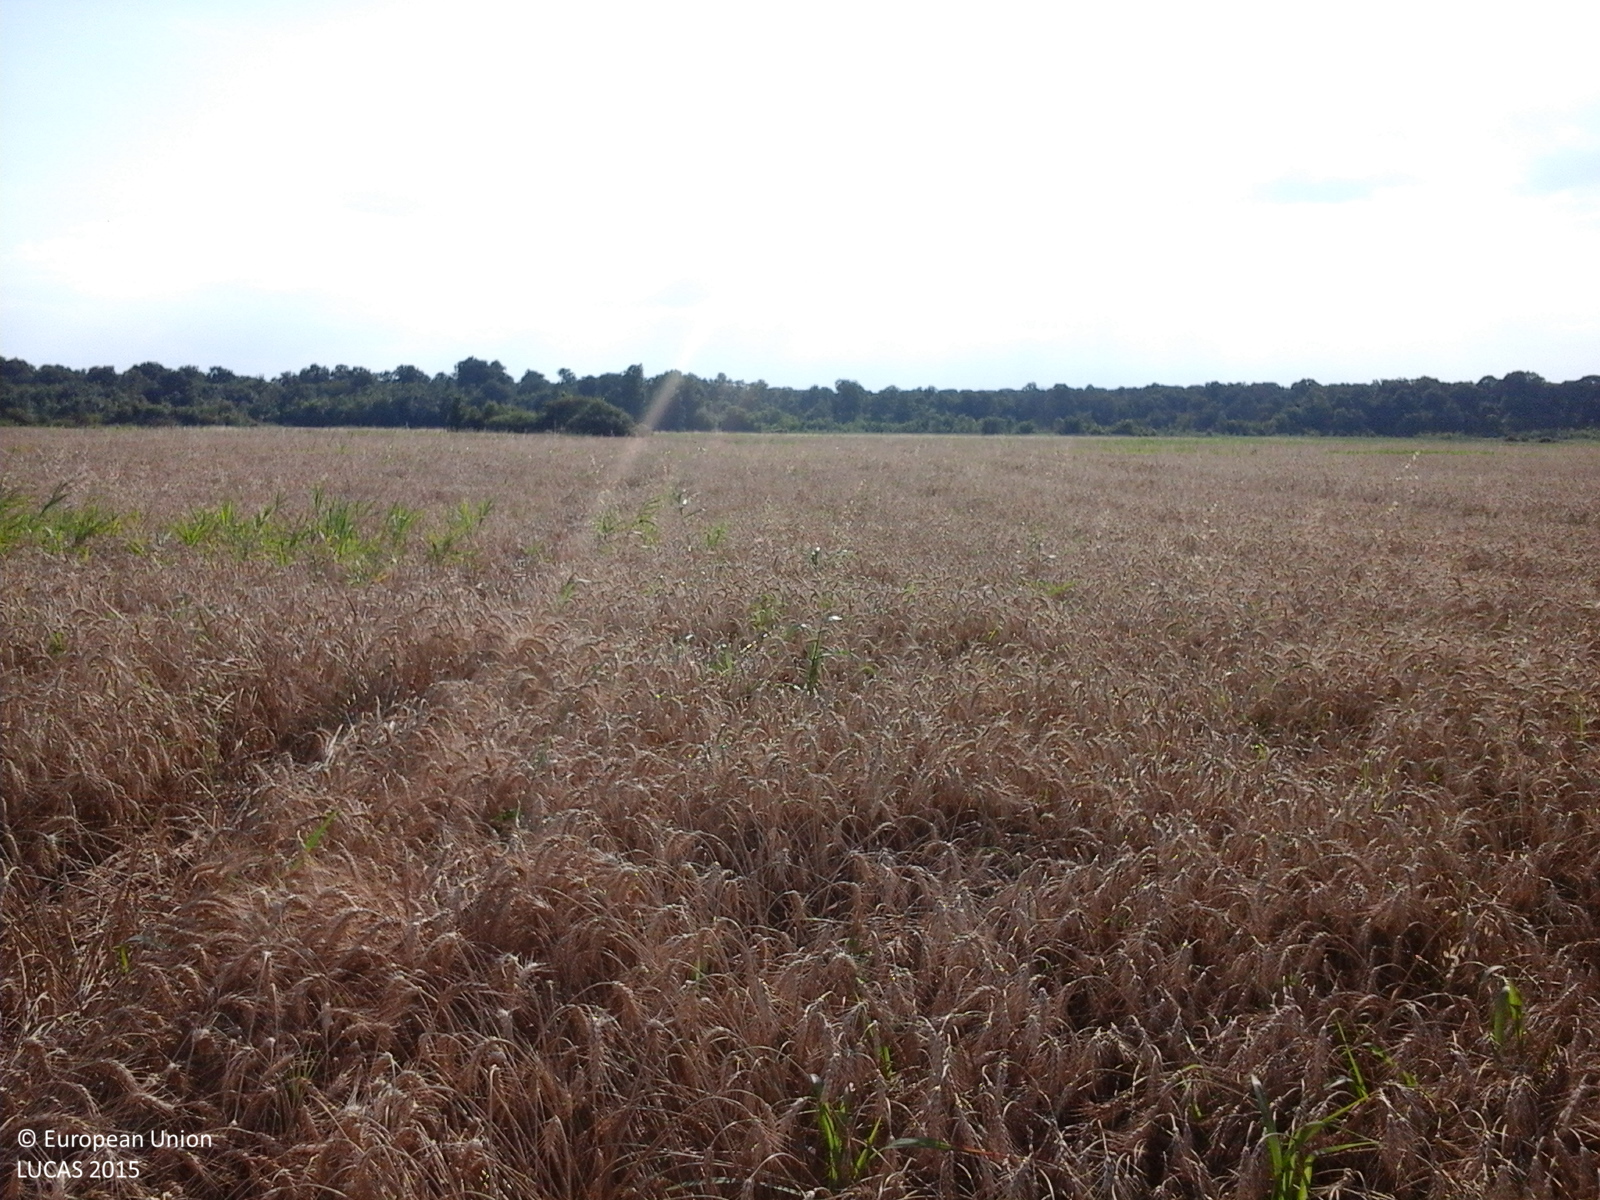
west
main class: Cropland
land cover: Common wheat
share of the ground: > 75 %
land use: Agriculture (excluding fallow land and kitchen gardens)
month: July
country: RO
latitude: 44.1728
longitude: 24.4632
